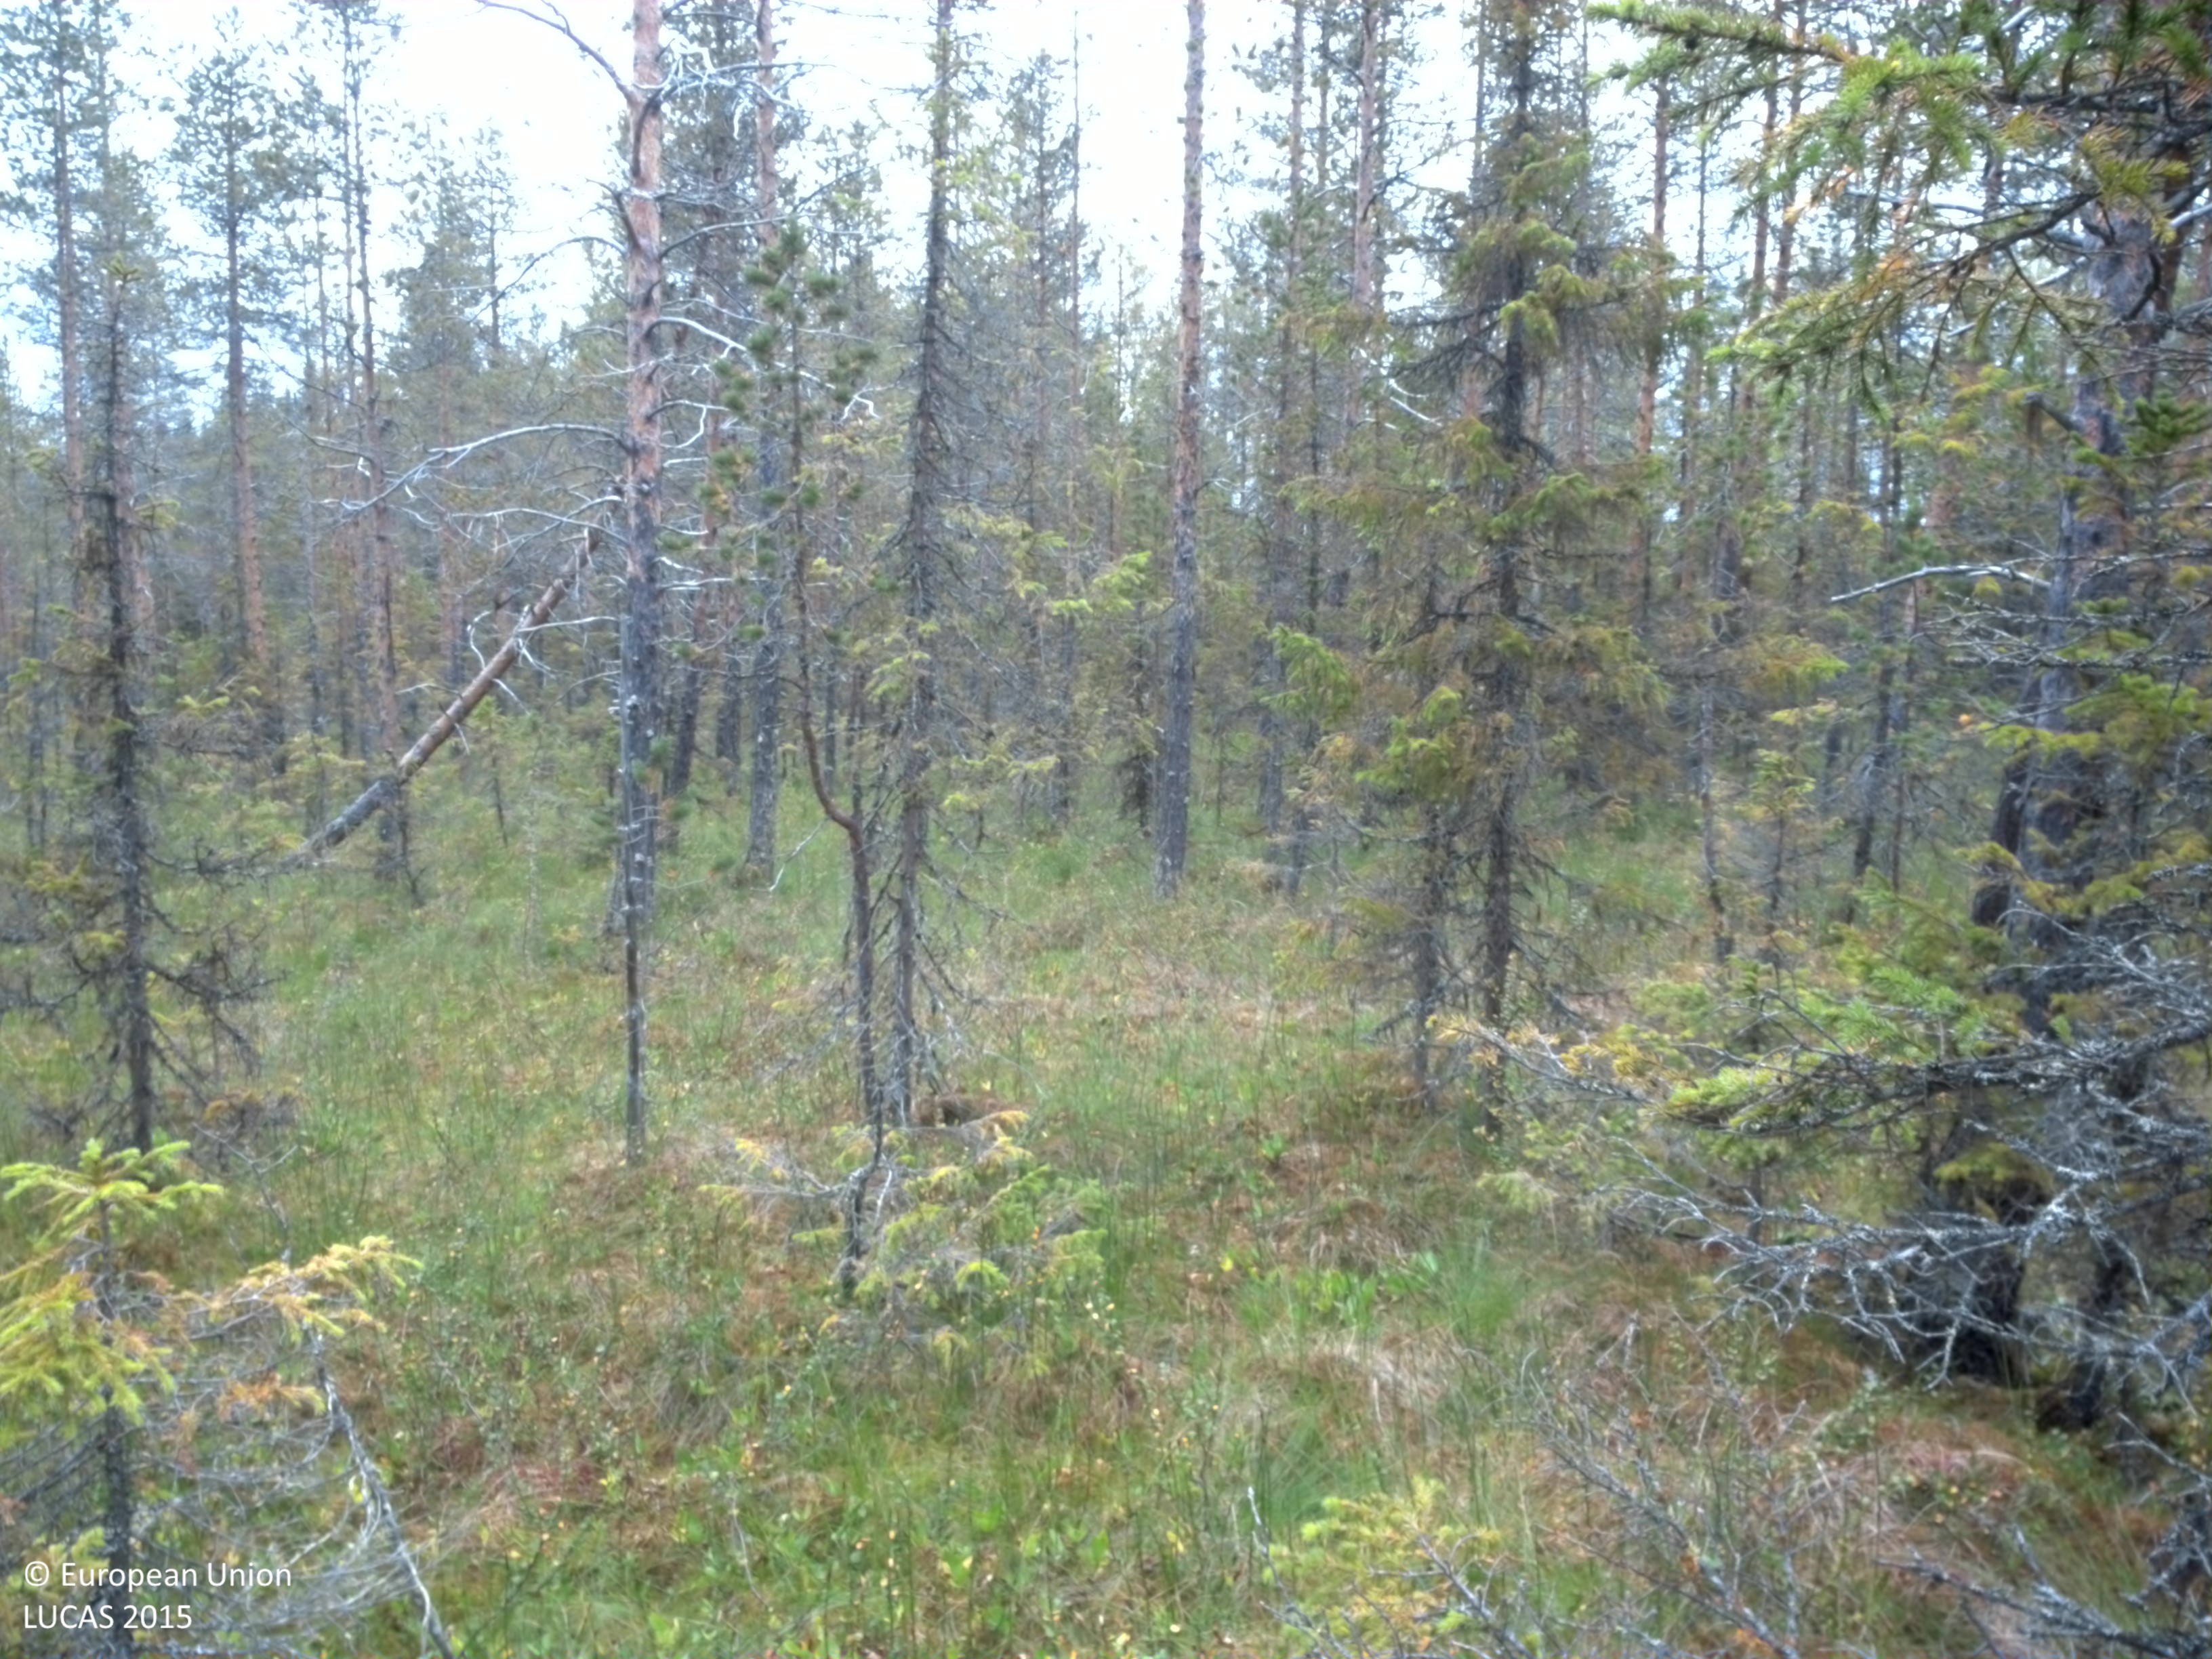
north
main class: Woodland
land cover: Pine dominated coniferous woodland
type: mire and swamp forests
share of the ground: 10 - 25 %
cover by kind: lichens and mosses 35 %, herbaceous plants 30 %, coniferous forest trees 20 %, shrubs 15 %
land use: Semi-natural and natural areas not in use
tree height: > 5 m
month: August
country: SE
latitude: 64.7476
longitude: 16.6678
